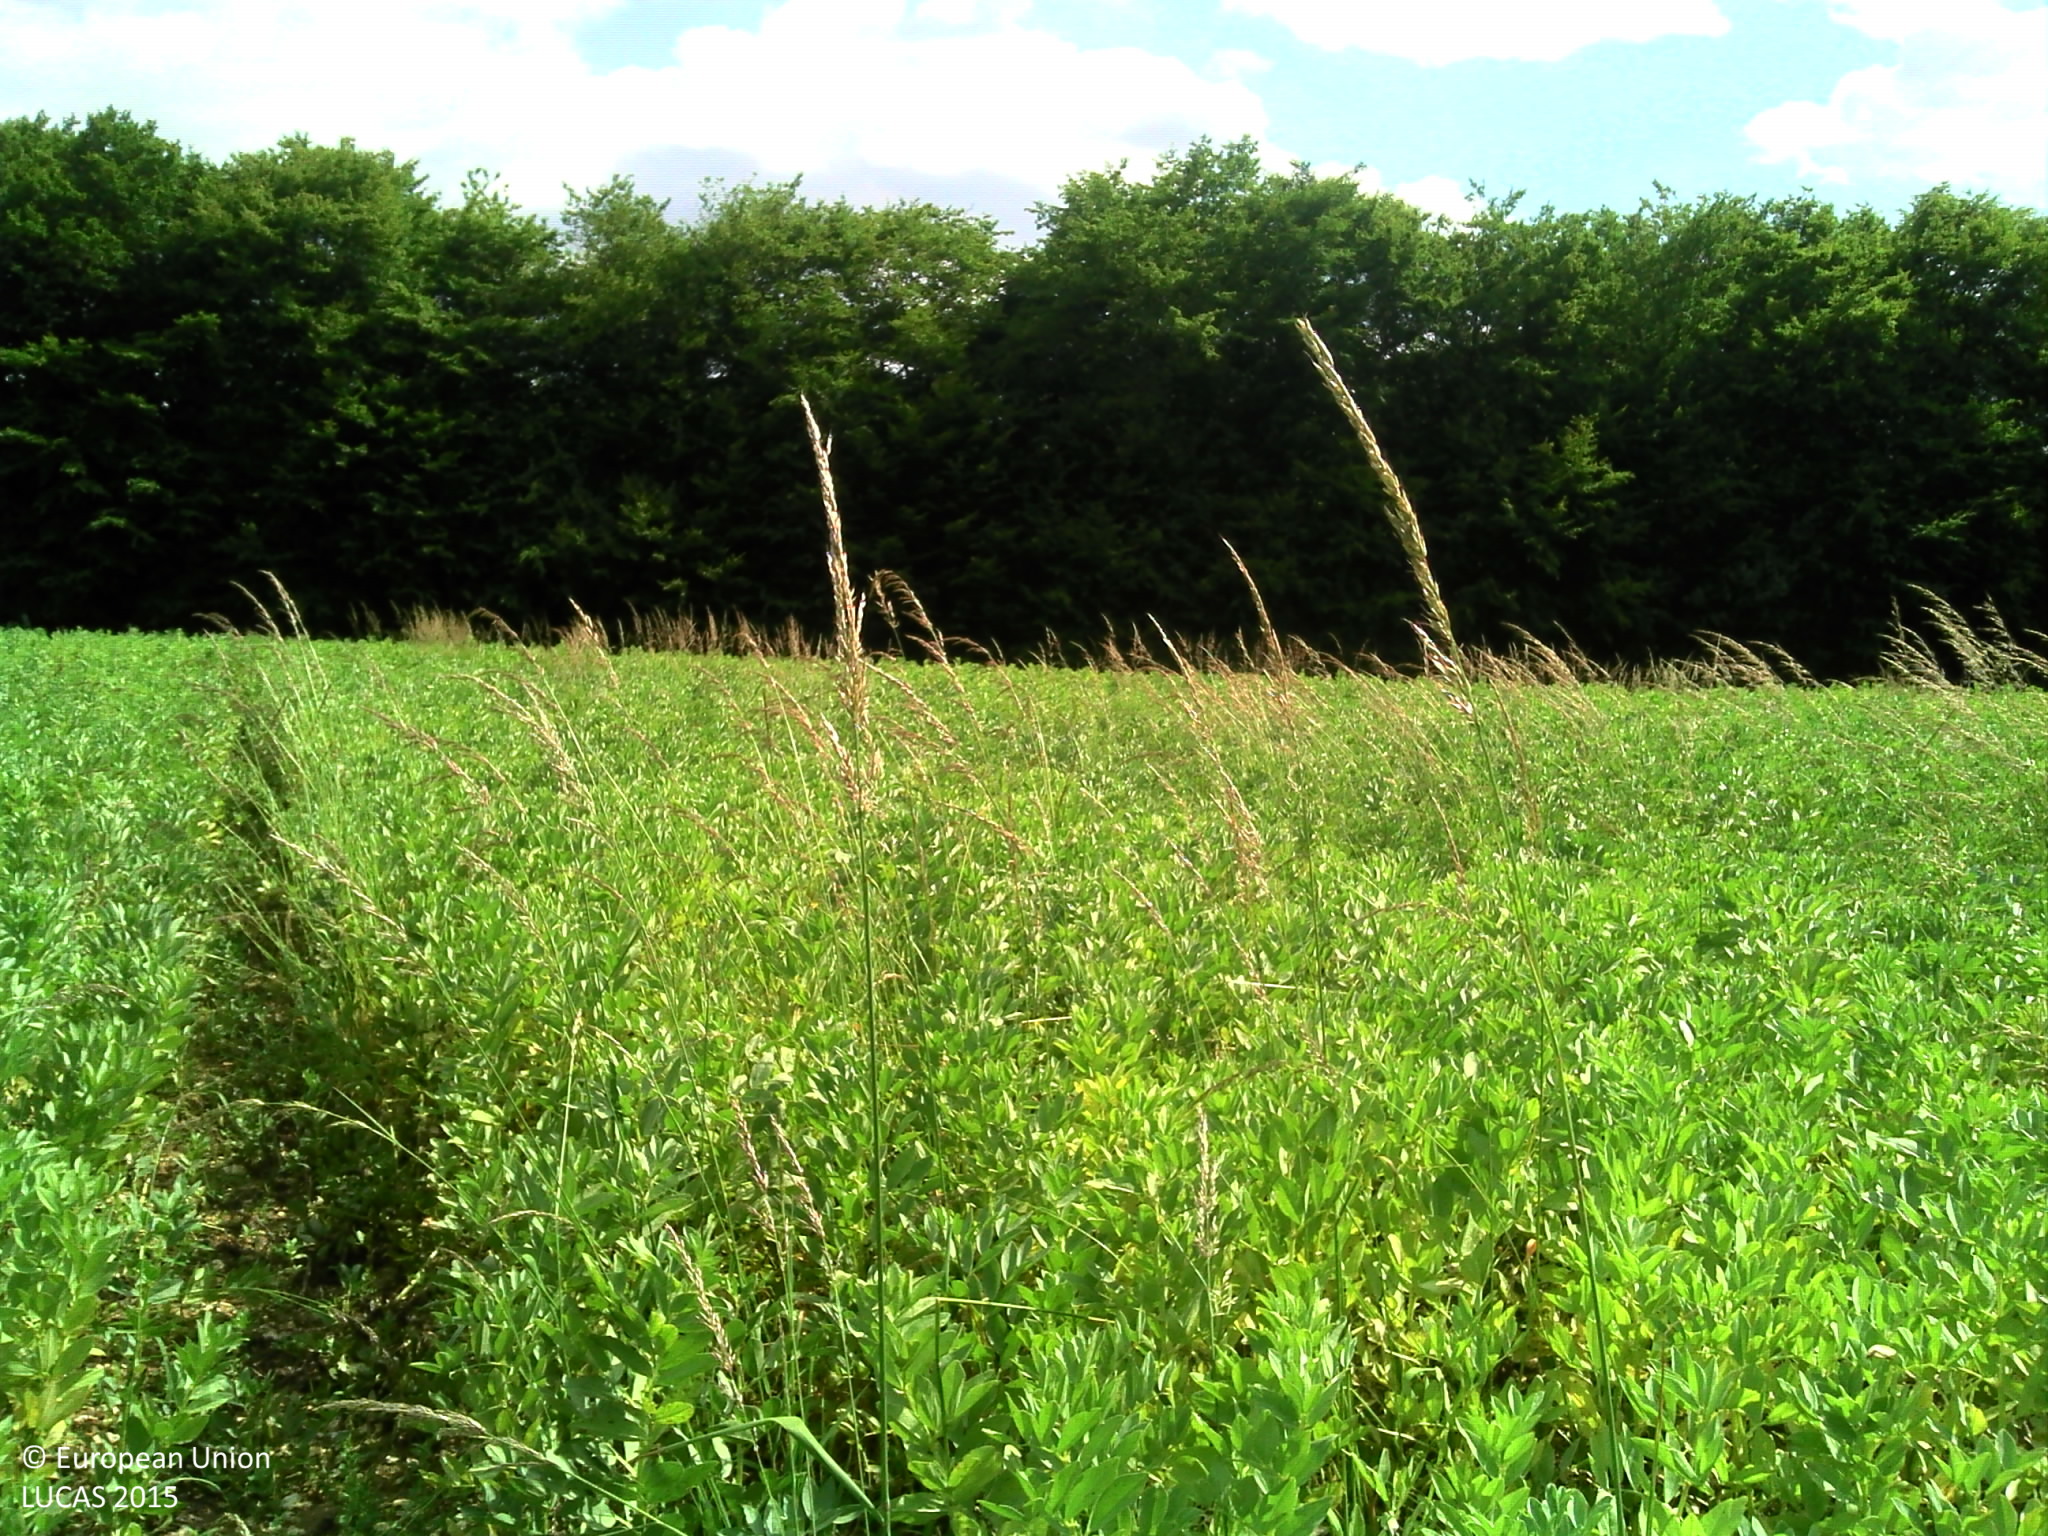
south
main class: Cropland
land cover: Dry pulses
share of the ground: > 75 %
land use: Agriculture (excluding fallow land and kitchen gardens)
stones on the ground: 10 - 25 %
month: June
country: FR
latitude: 47.3937
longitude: 2.5601
